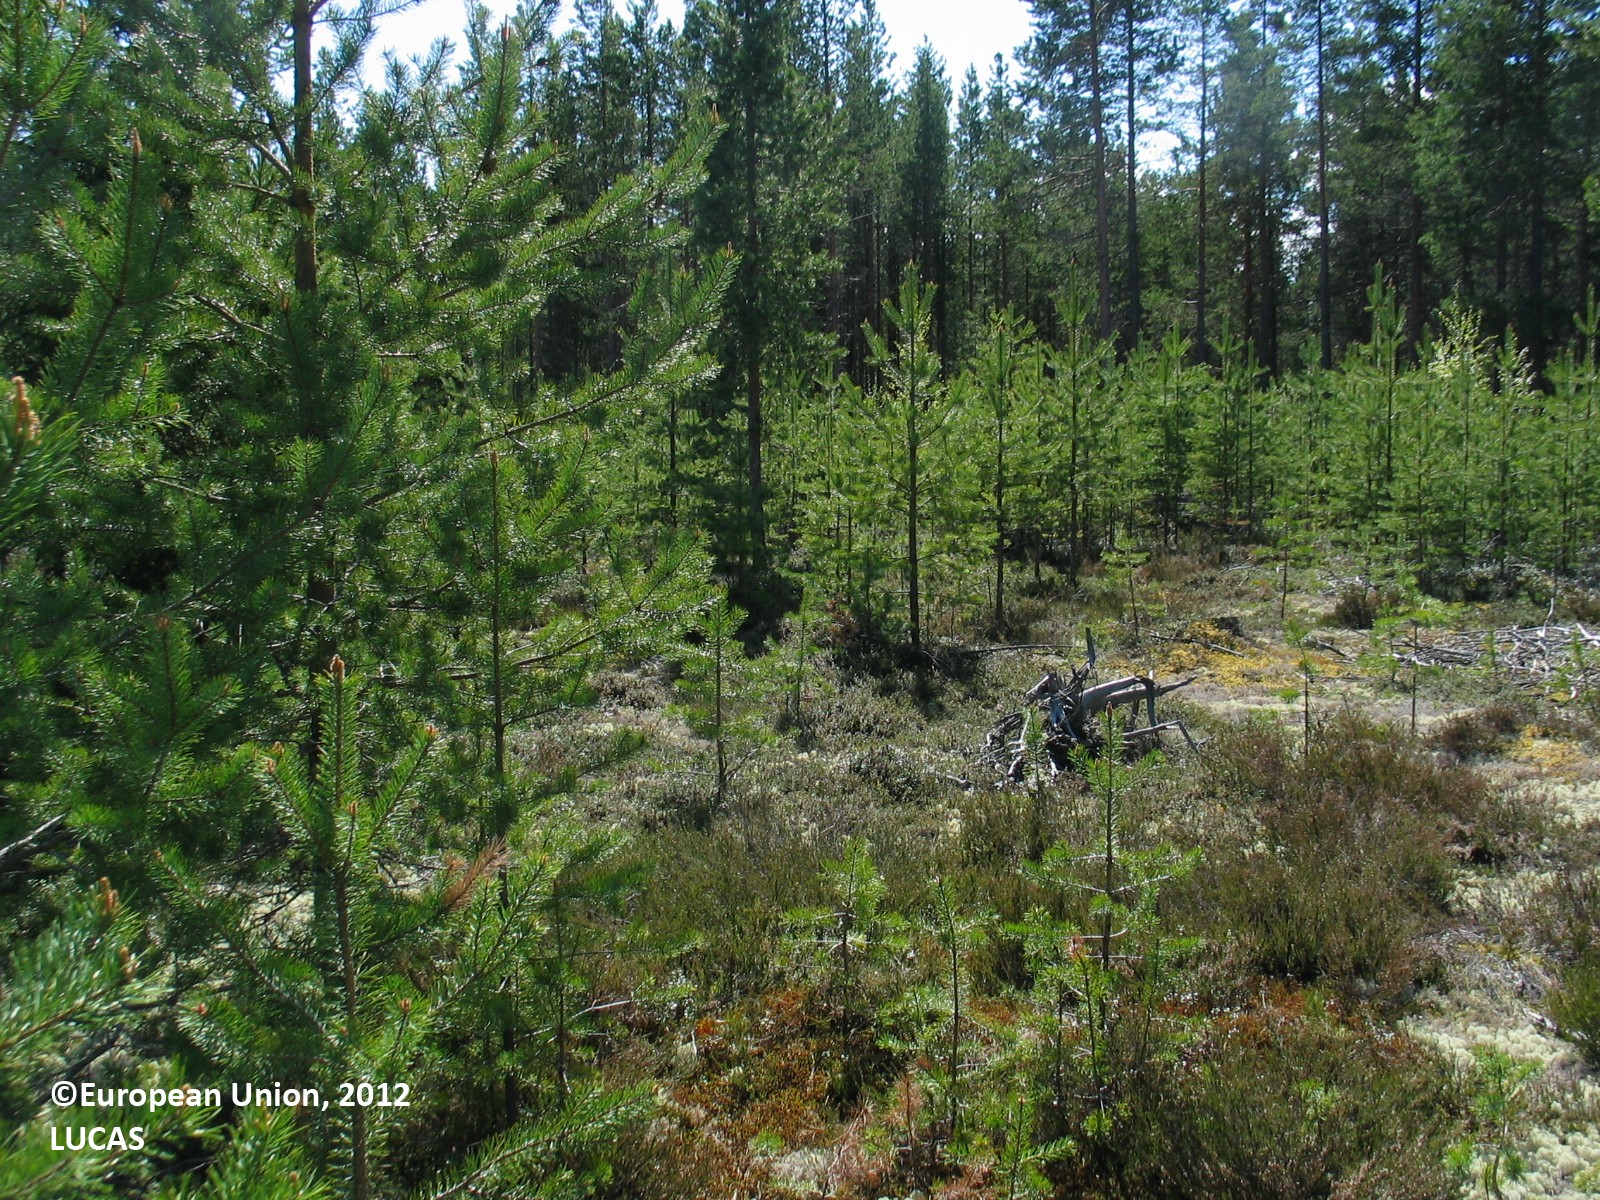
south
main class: Woodland
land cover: Pine dominated coniferous woodland
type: boreal forest
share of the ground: 25 - 50 %
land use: Forestry
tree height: < 5 m
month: May
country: FI
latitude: 64.9440
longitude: 25.2958
